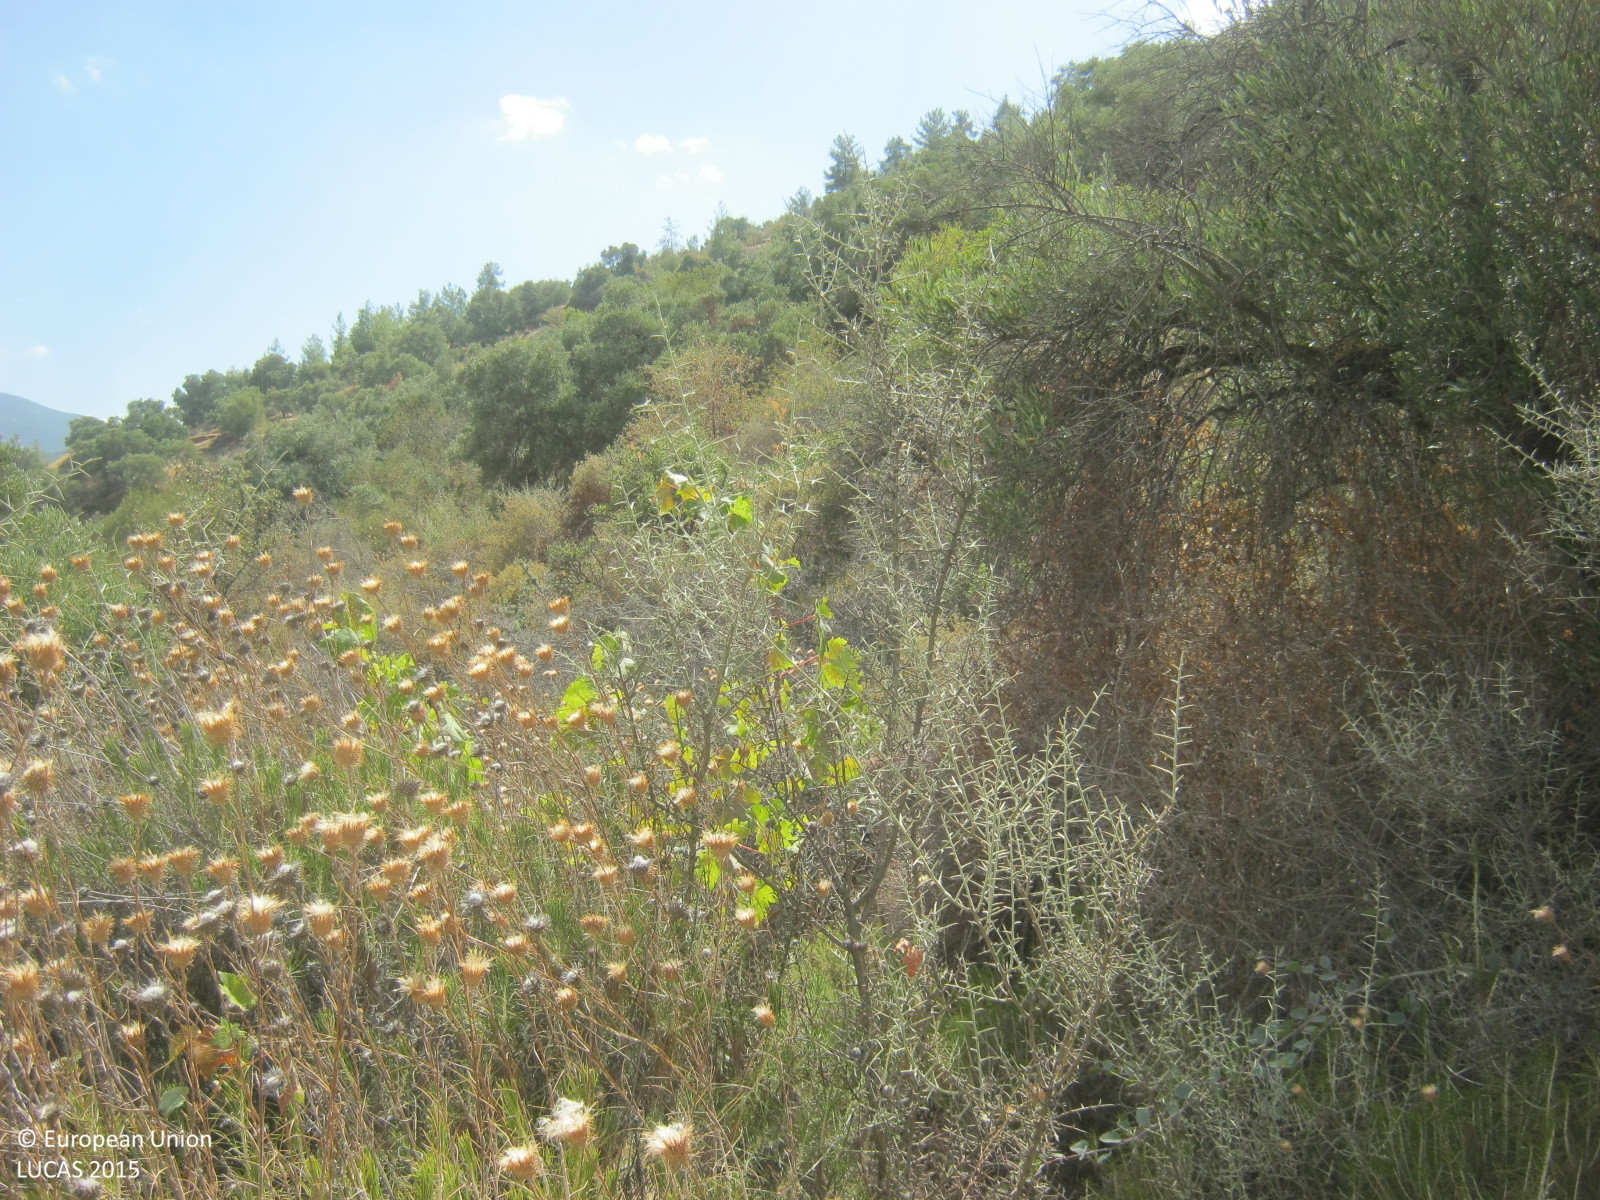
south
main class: Woodland
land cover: Other mixed woodland
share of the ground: 25 - 50 %
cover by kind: shrubs 30 %, herbaceous plants 30 %, broadleaved forest trees 25 %, coniferous forest trees 15 %
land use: Semi-natural and natural areas not in use
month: September
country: CY
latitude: 35.0265
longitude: 32.8228
